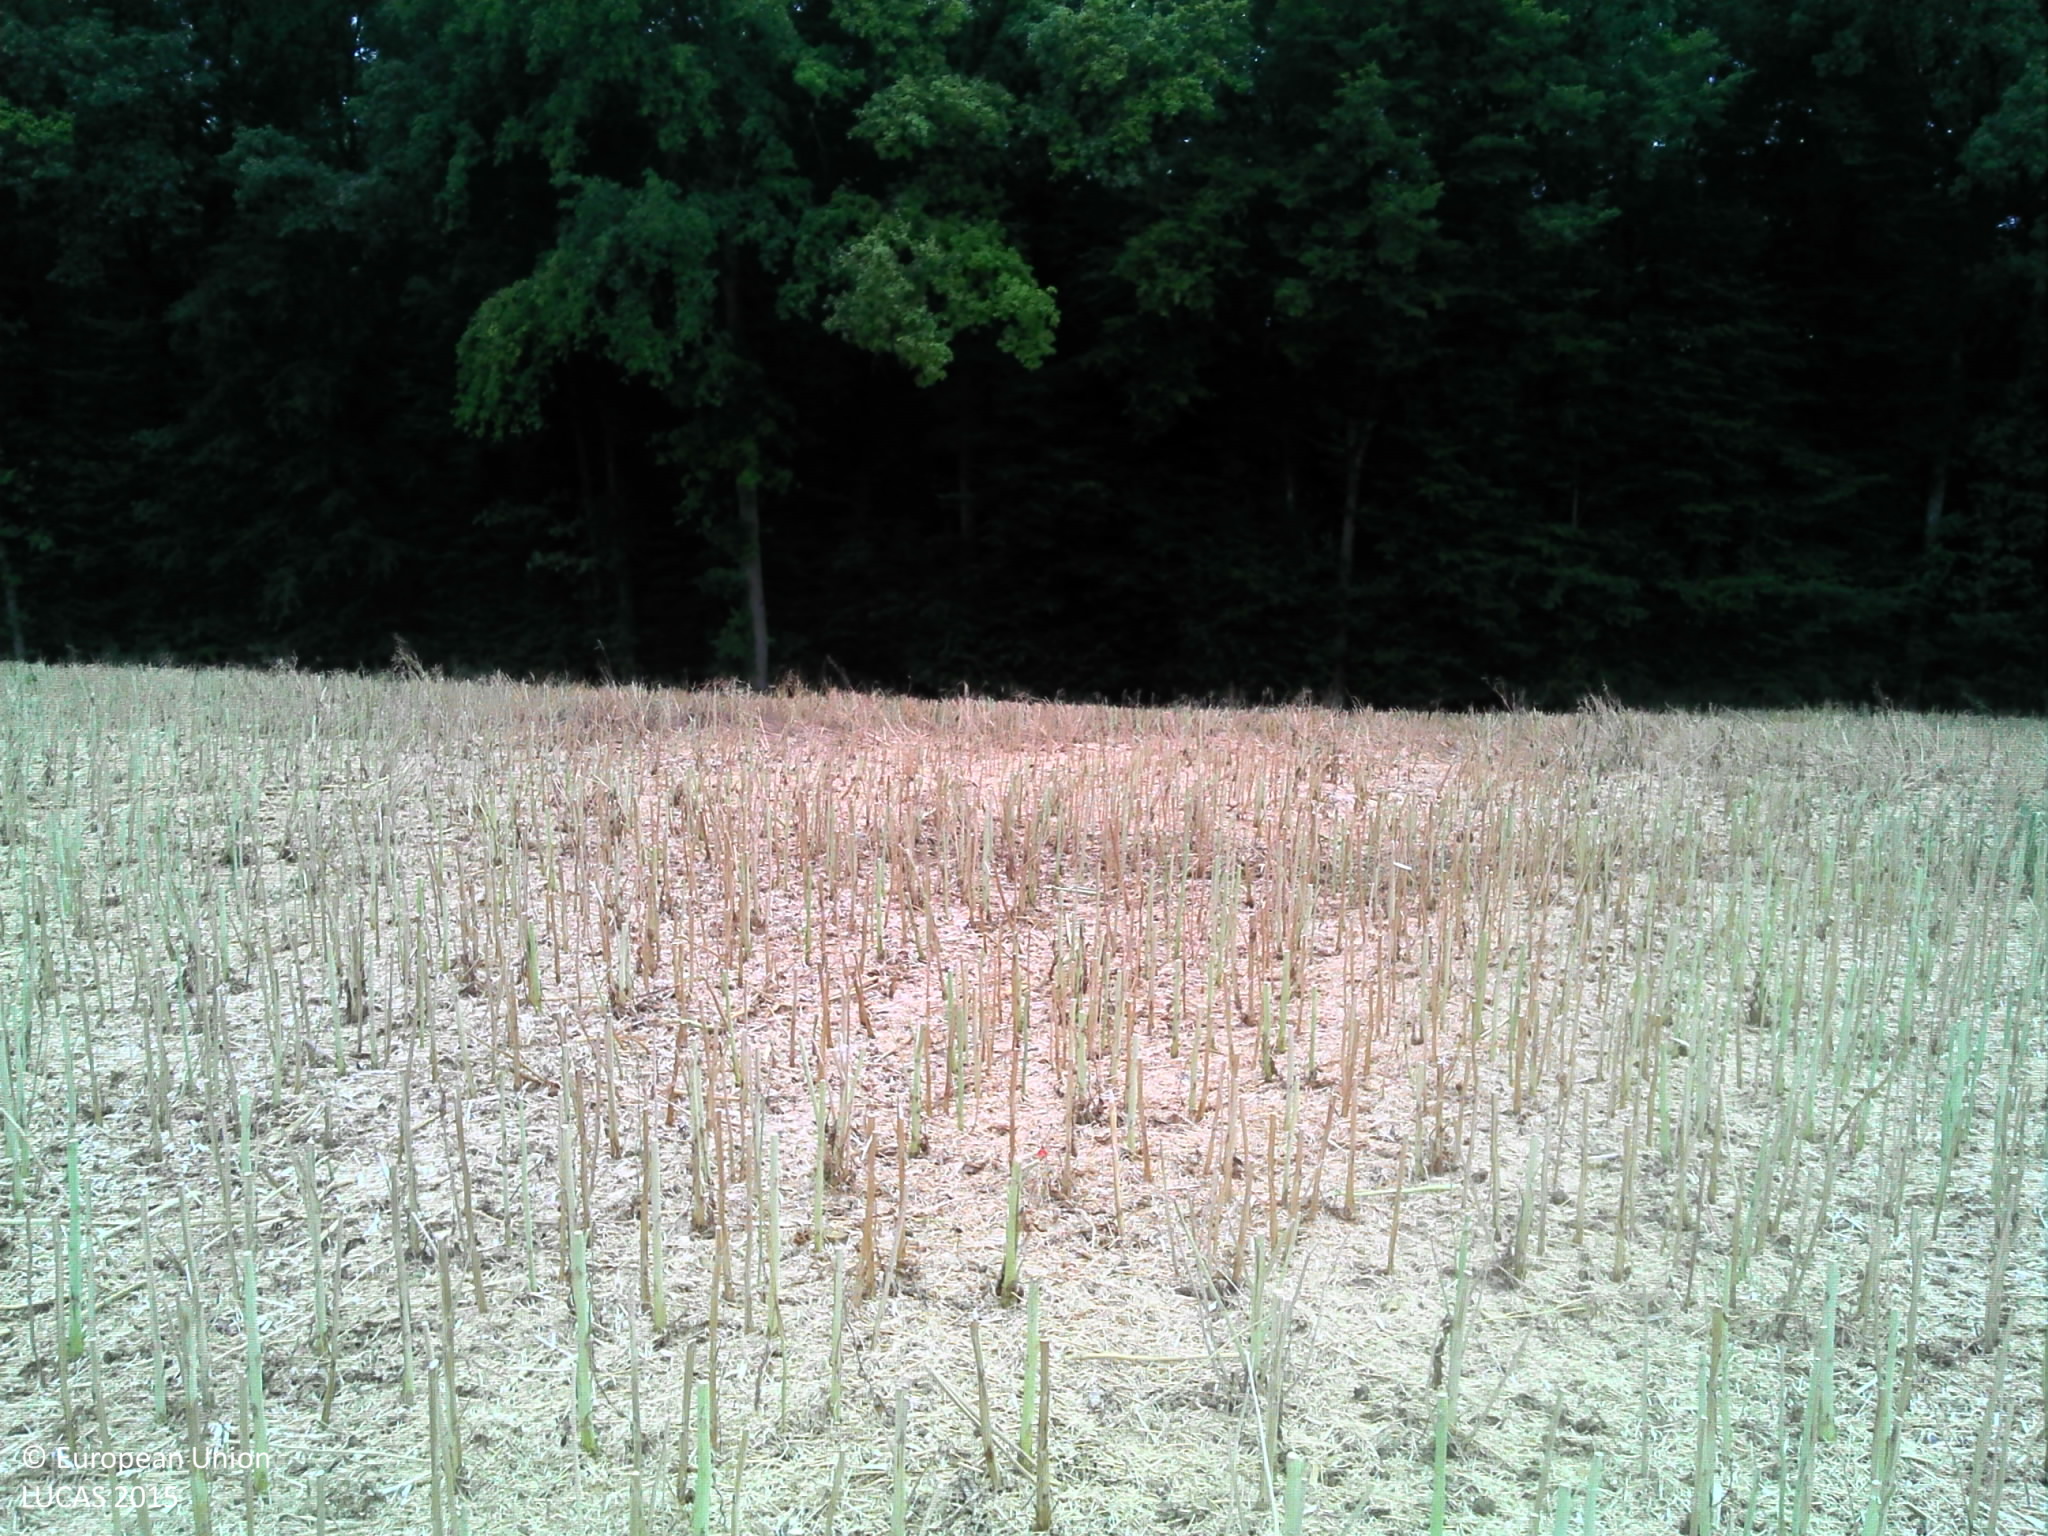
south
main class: Cropland
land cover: Rape and turnip rape
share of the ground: > 75 %
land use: Agriculture (excluding fallow land and kitchen gardens)
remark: Harvested field
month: July
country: FR
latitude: 48.1223
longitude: 3.5060
